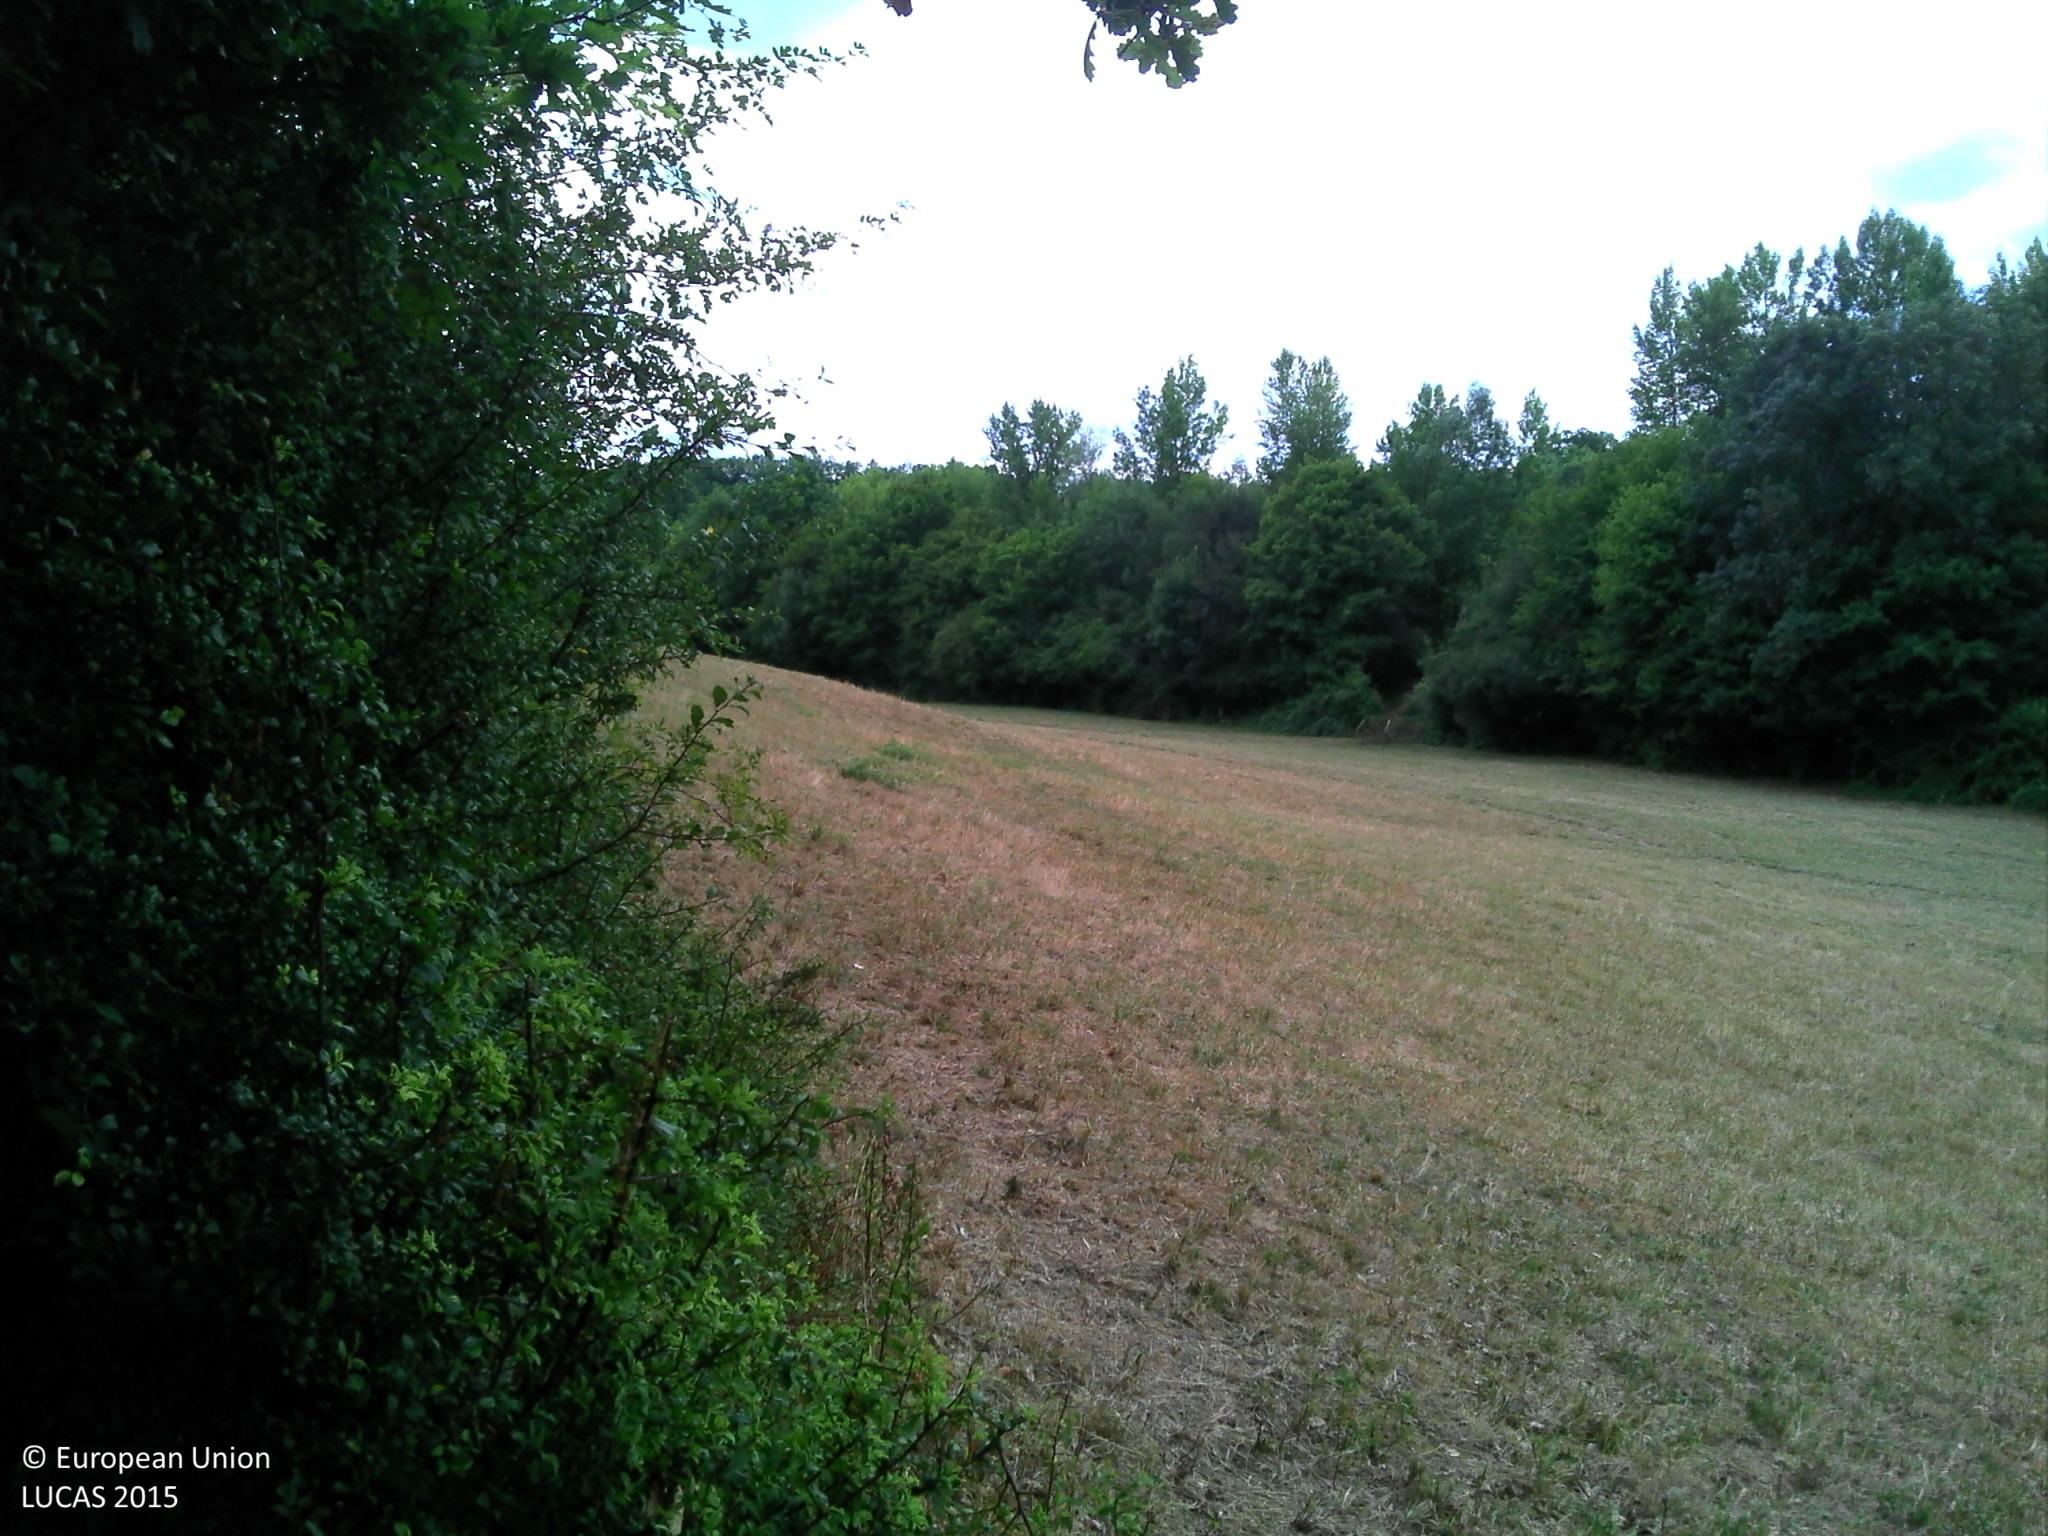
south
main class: Woodland
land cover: Broadleaved woodland
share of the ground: > 75 %
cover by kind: broadleaved forest trees 80 %, shrubs 20 %
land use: Agriculture (excluding fallow land and kitchen gardens)
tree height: > 5 m
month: July
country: FR
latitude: 44.6688
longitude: 0.8235
